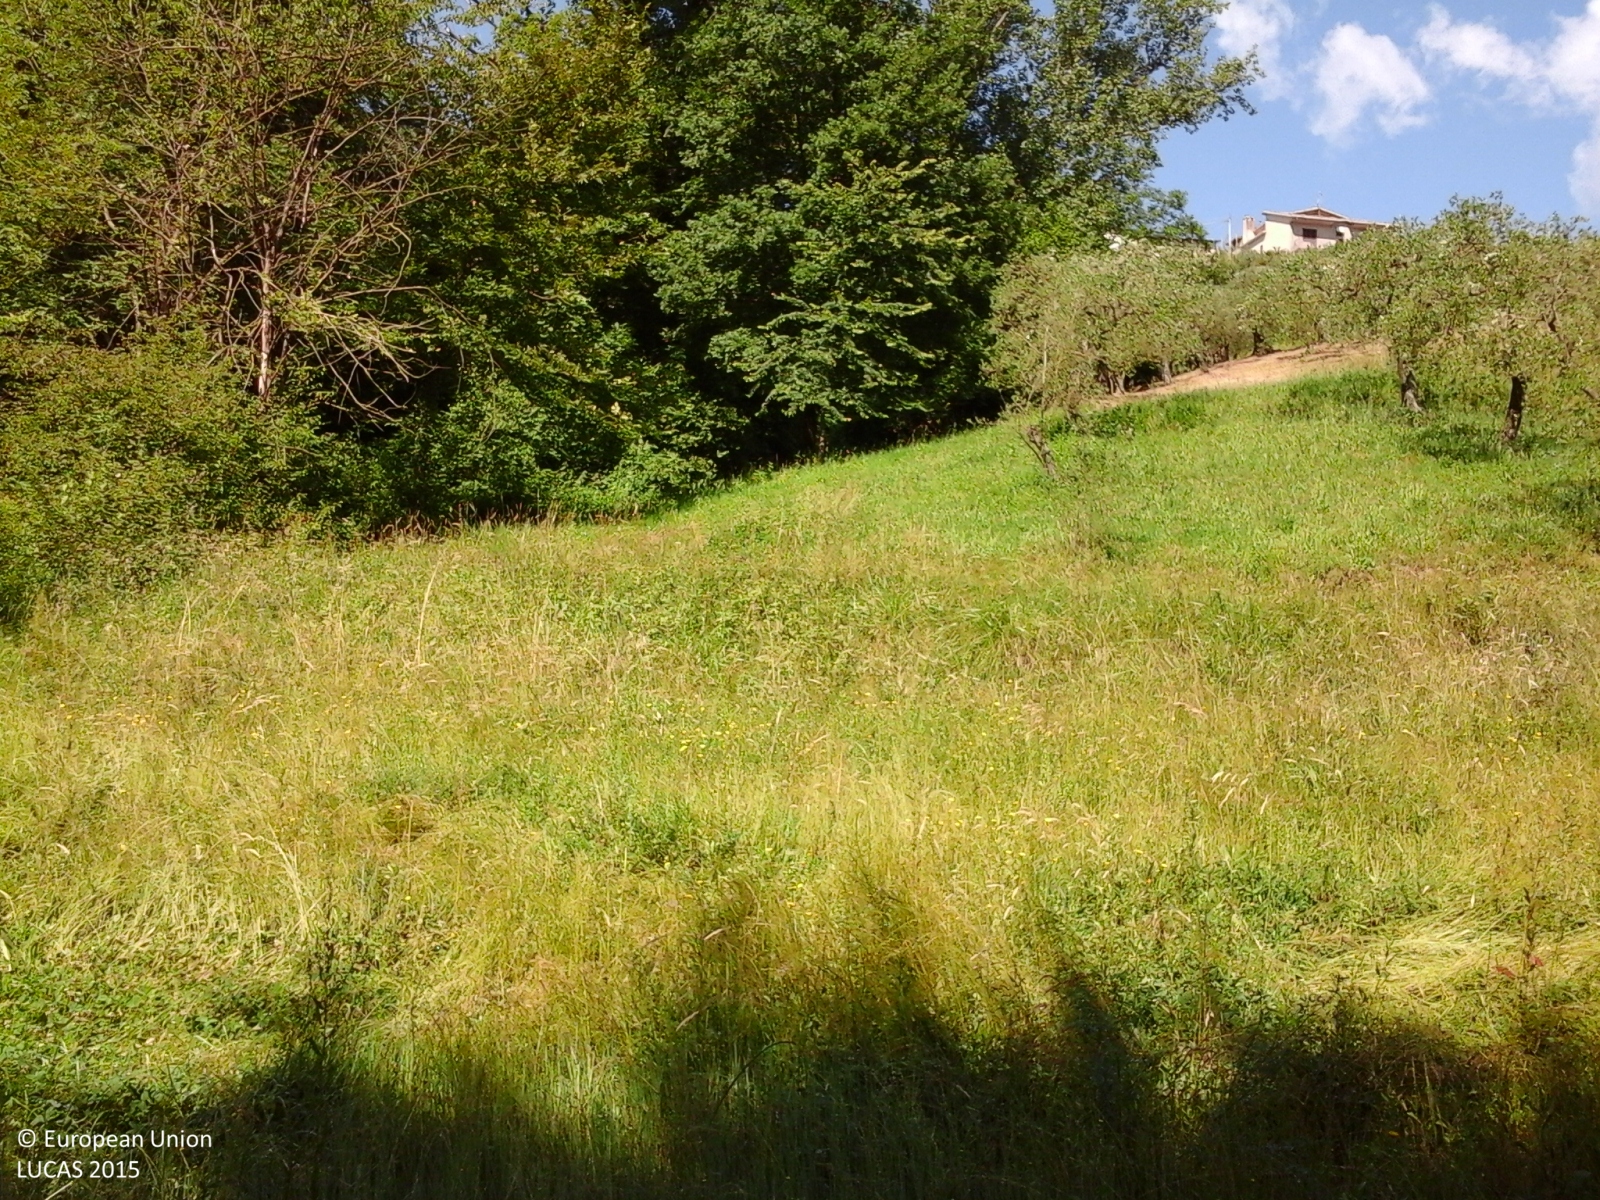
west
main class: Grassland
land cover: Grassland with sparse tree/shrub cover
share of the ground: 50 - 75 %
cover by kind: herbaceous plants 90 %, broadleaved forest trees 5 %, shrubs 5 %
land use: Agriculture (excluding fallow land and kitchen gardens)
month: May
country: IT
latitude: 41.6933
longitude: 13.3877
